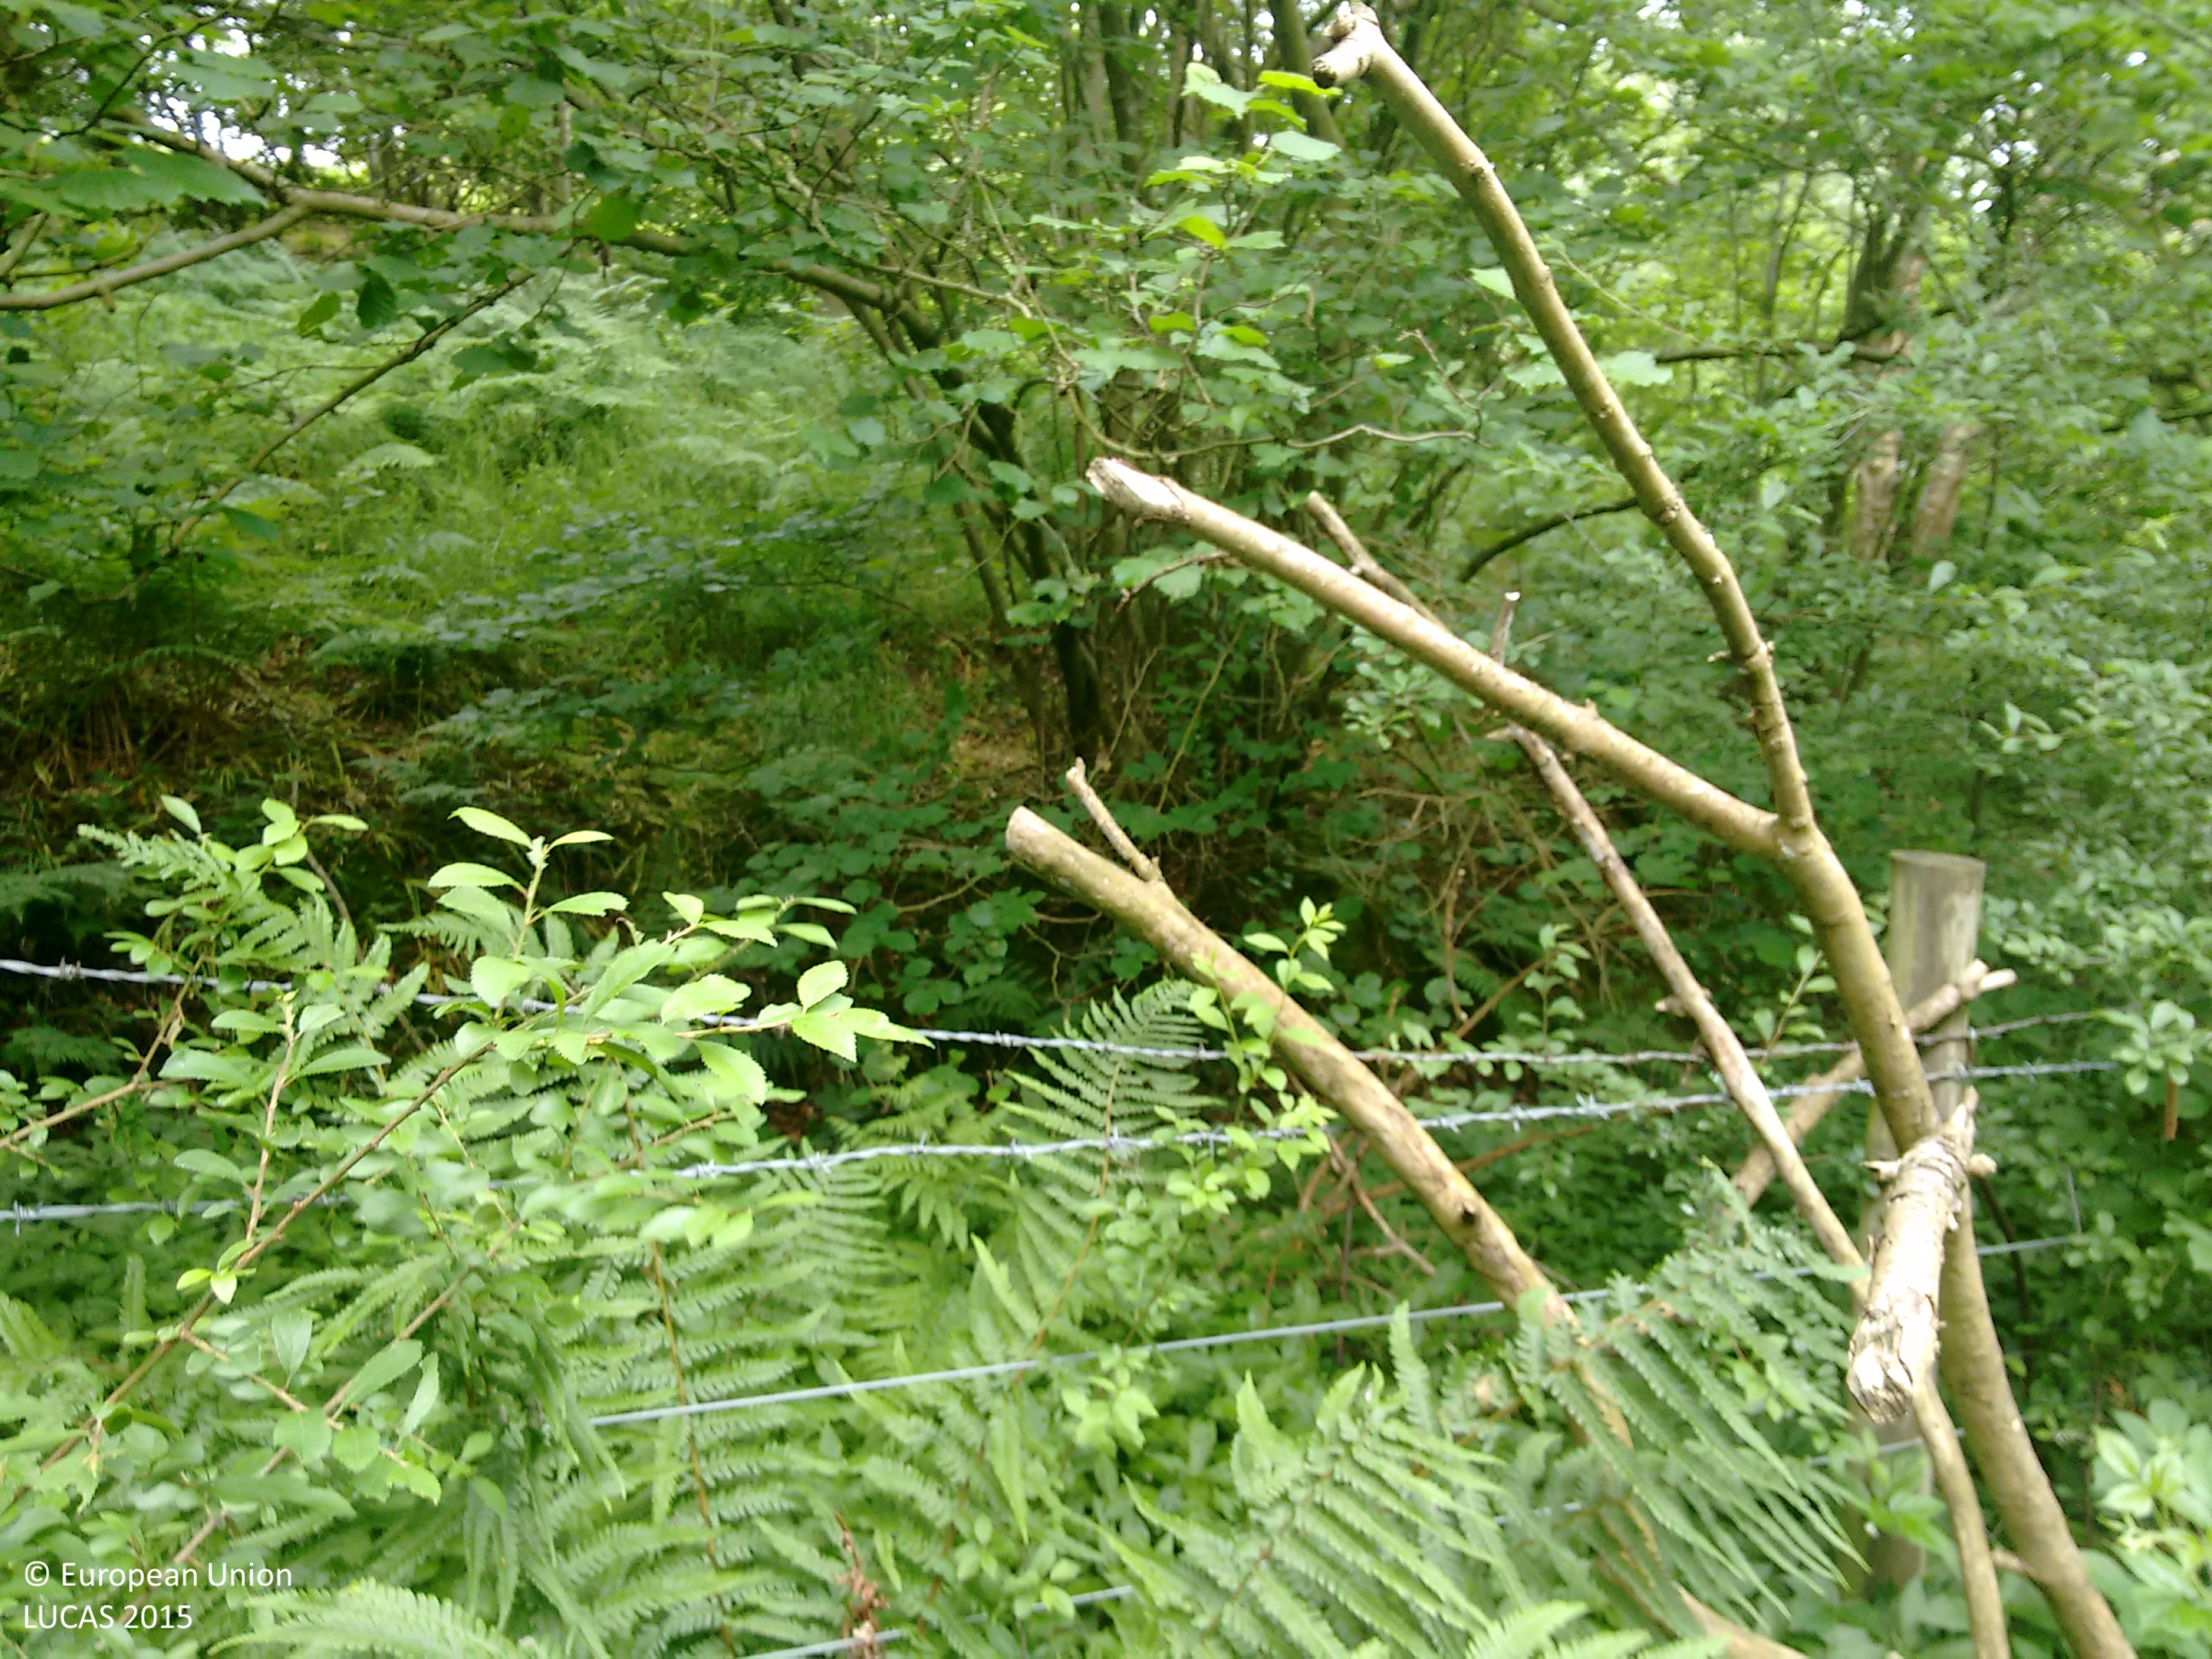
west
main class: Woodland
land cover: Broadleaved woodland
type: mesophytic deciduous forest
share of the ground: > 75 %
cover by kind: broadleaved forest trees 80 %, coniferous forest trees 20 %
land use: Forestry
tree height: > 5 m
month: June
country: GB
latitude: 54.4307
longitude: -1.1271
